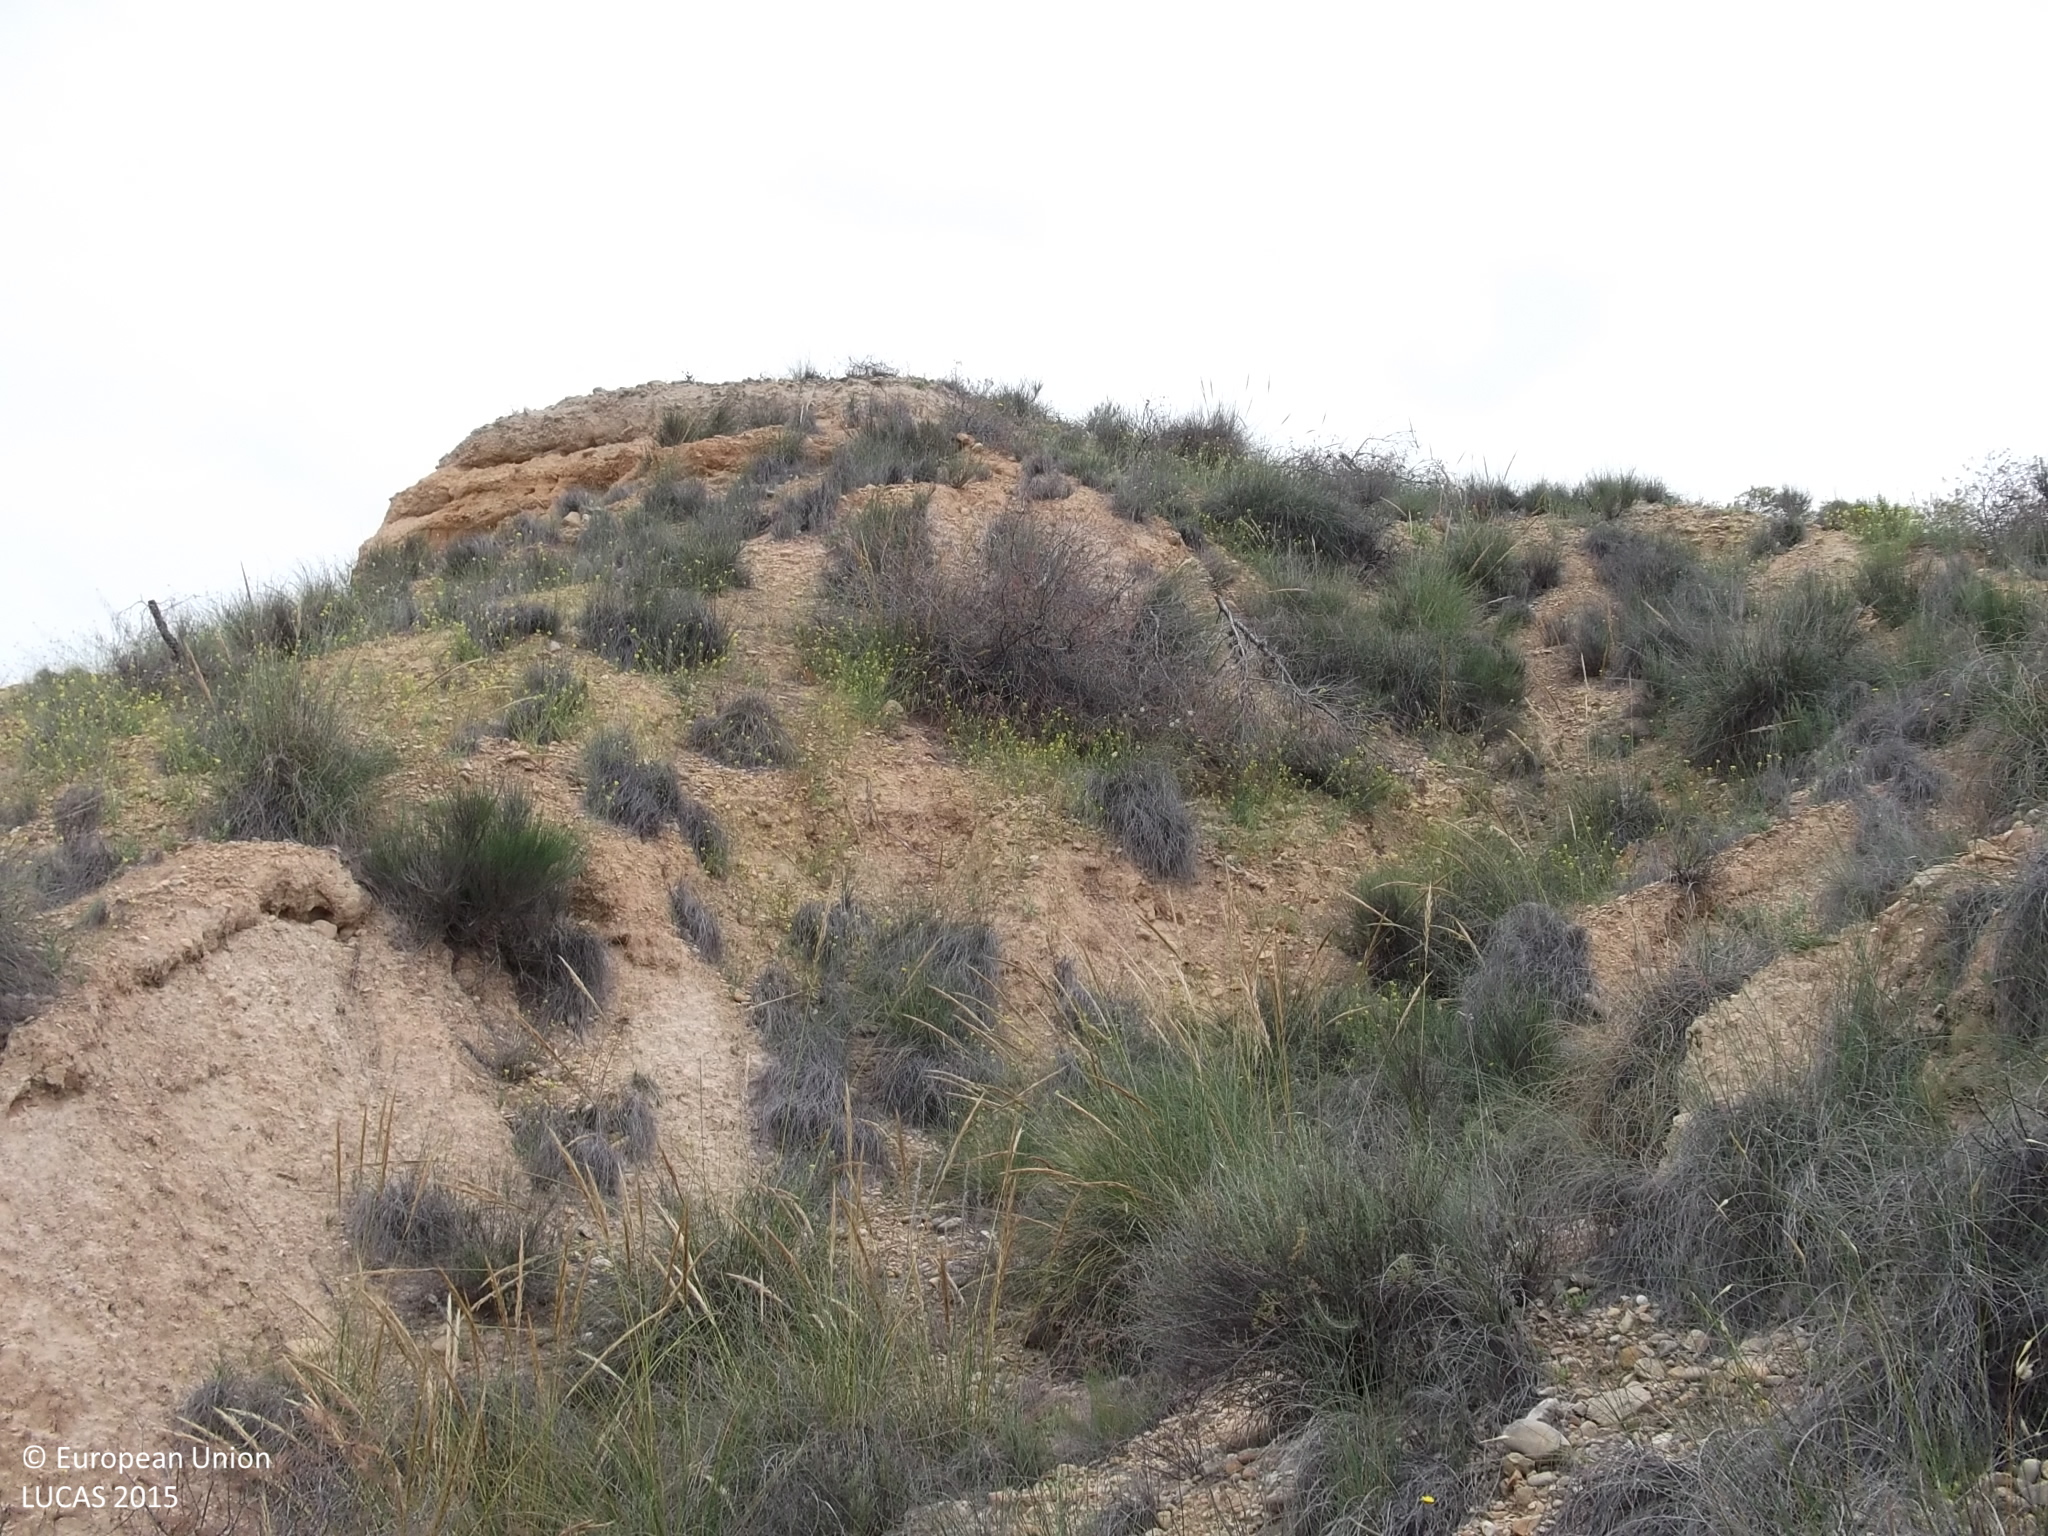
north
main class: Woodland
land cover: Pine dominated coniferous woodland
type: coniferous forest of the mediterranean region
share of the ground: 10 - 25 %
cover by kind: shrubs 40 %, consolidated bare surface 40 %, coniferous forest trees 20 %
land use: Semi-natural and natural areas not in use
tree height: > 5 m
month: April
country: ES
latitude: 37.9050
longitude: -1.3686
